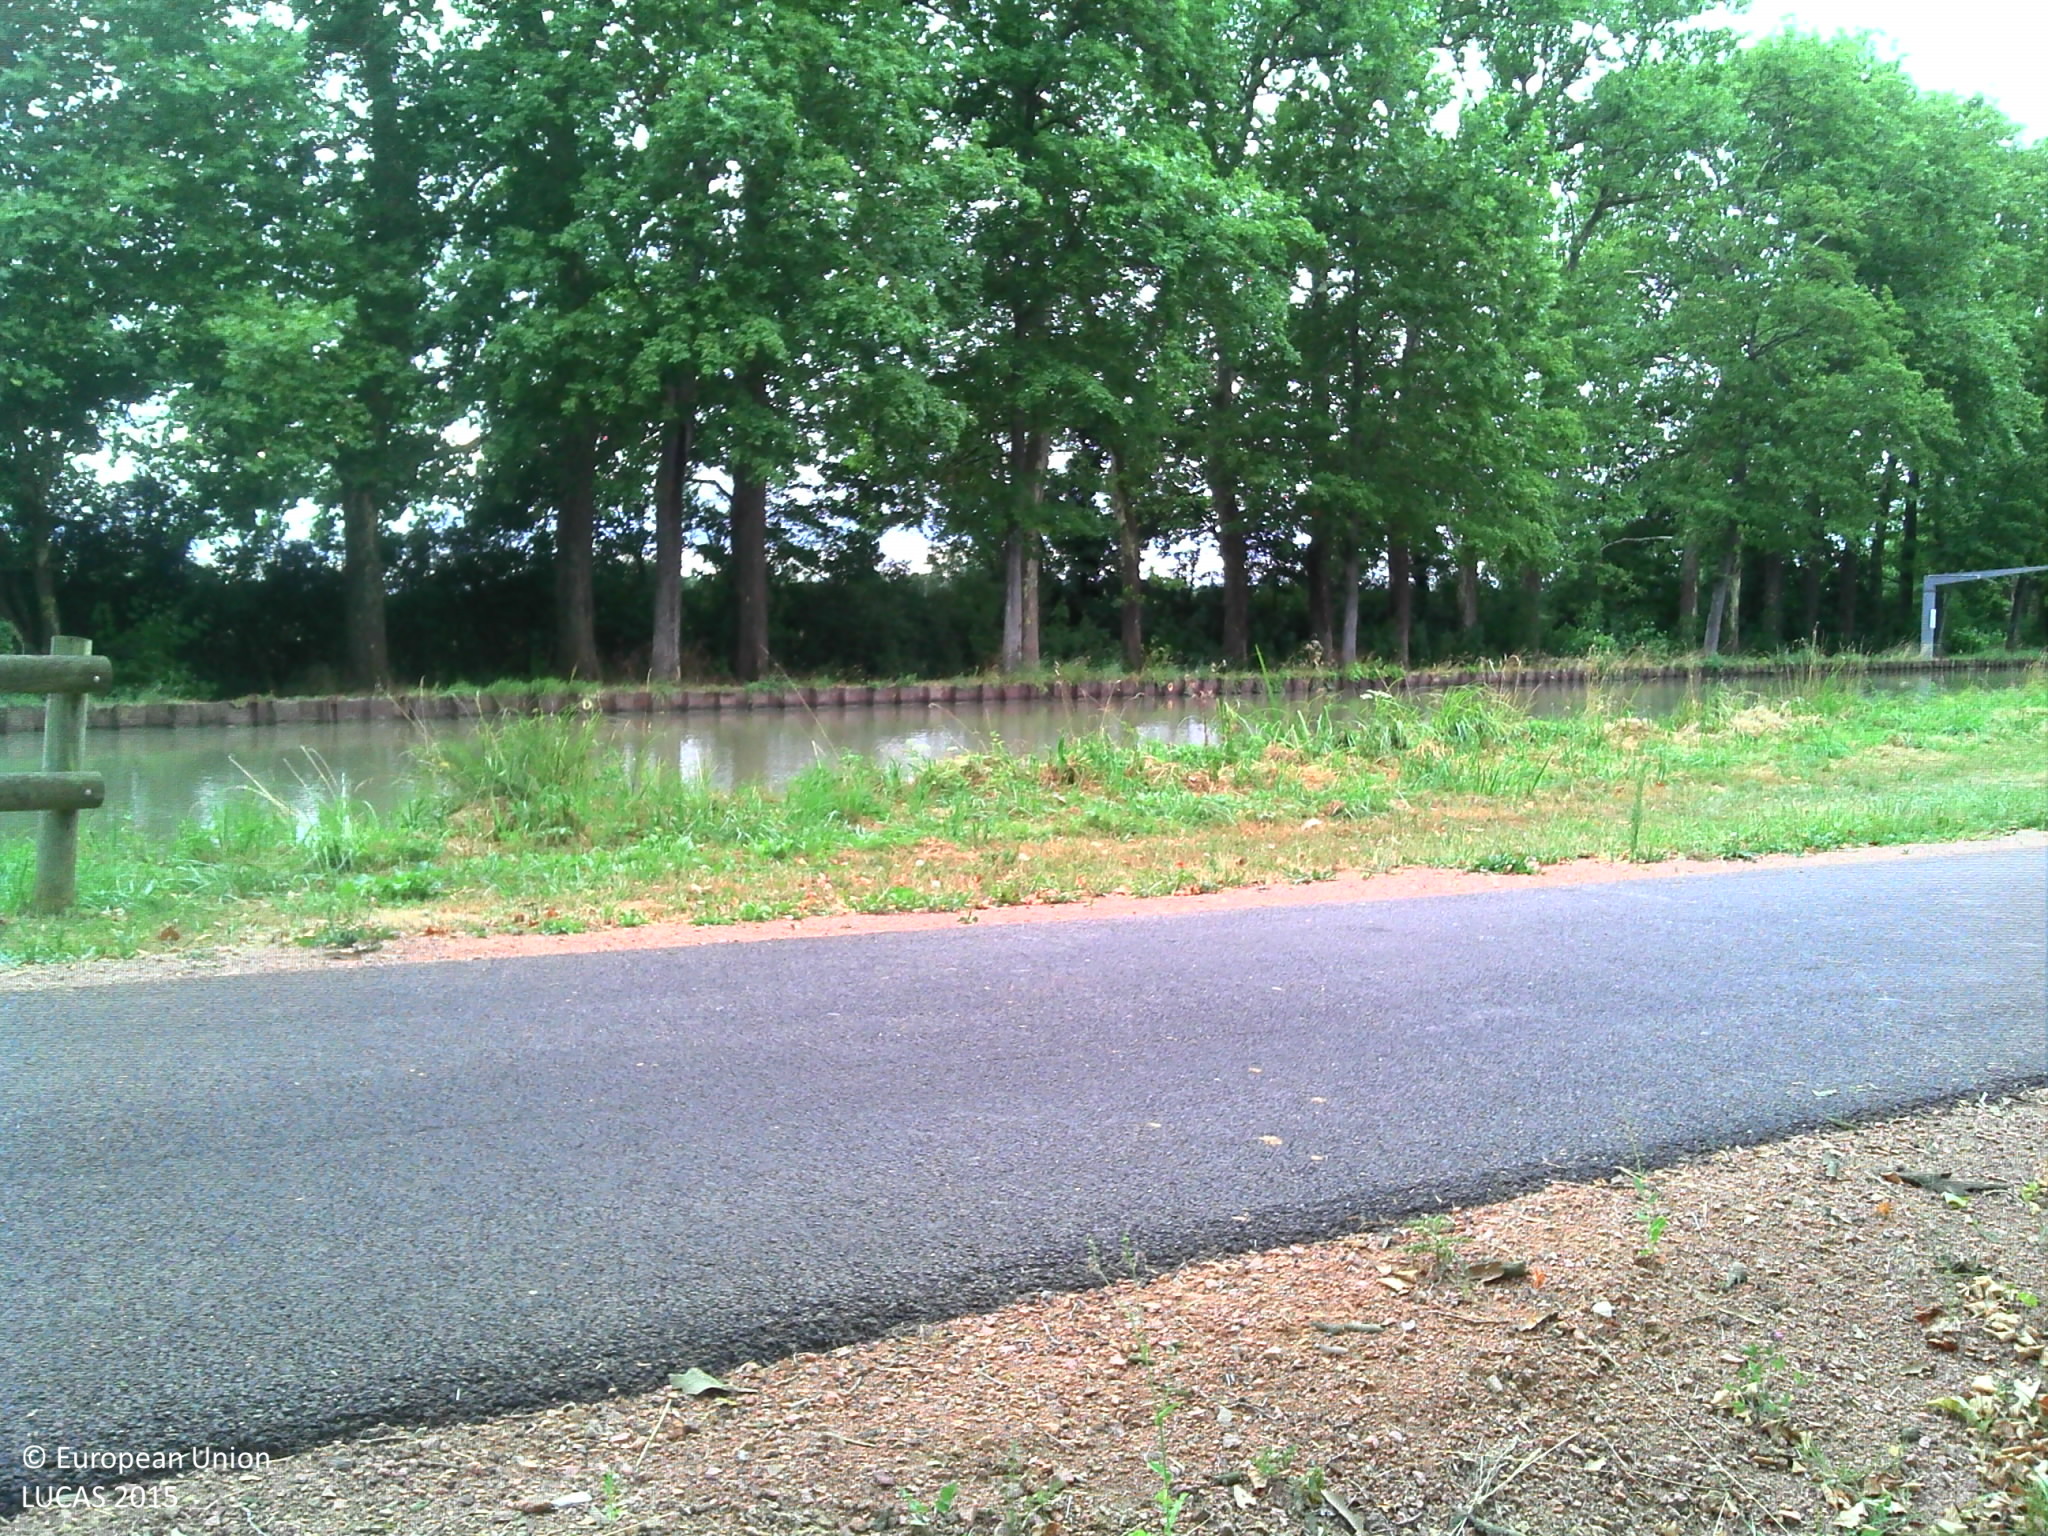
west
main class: Grassland
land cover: Grassland without tree/shrub cover
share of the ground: > 75 %
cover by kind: herbaceous plants 100 %
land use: Agriculture (excluding fallow land and kitchen gardens)
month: July
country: FR
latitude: 46.9644
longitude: 3.1755
